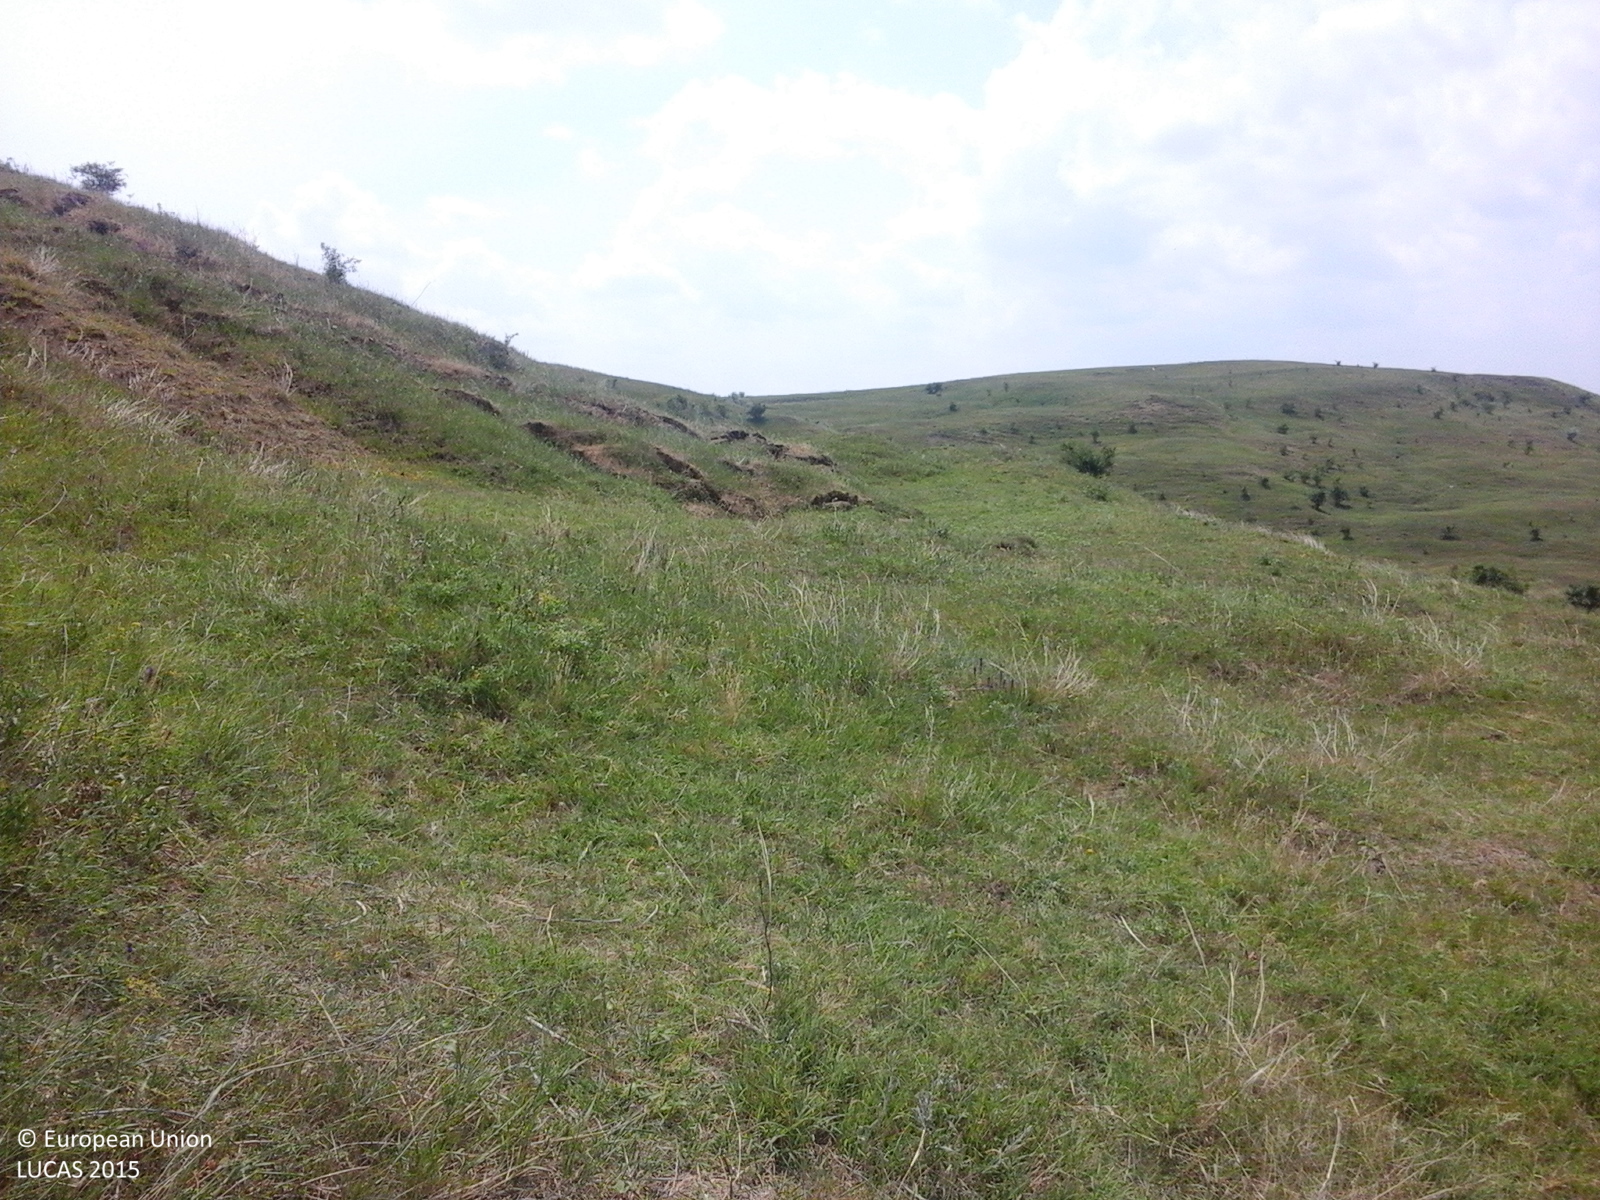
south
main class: Grassland
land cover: Grassland with sparse tree/shrub cover
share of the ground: > 75 %
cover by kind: herbaceous plants 90 %, broadleaved forest trees 5 %, shrubs 5 %
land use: Agriculture (excluding fallow land and kitchen gardens)
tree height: < 5 m
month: June
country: RO
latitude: 47.4094
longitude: 26.9721
